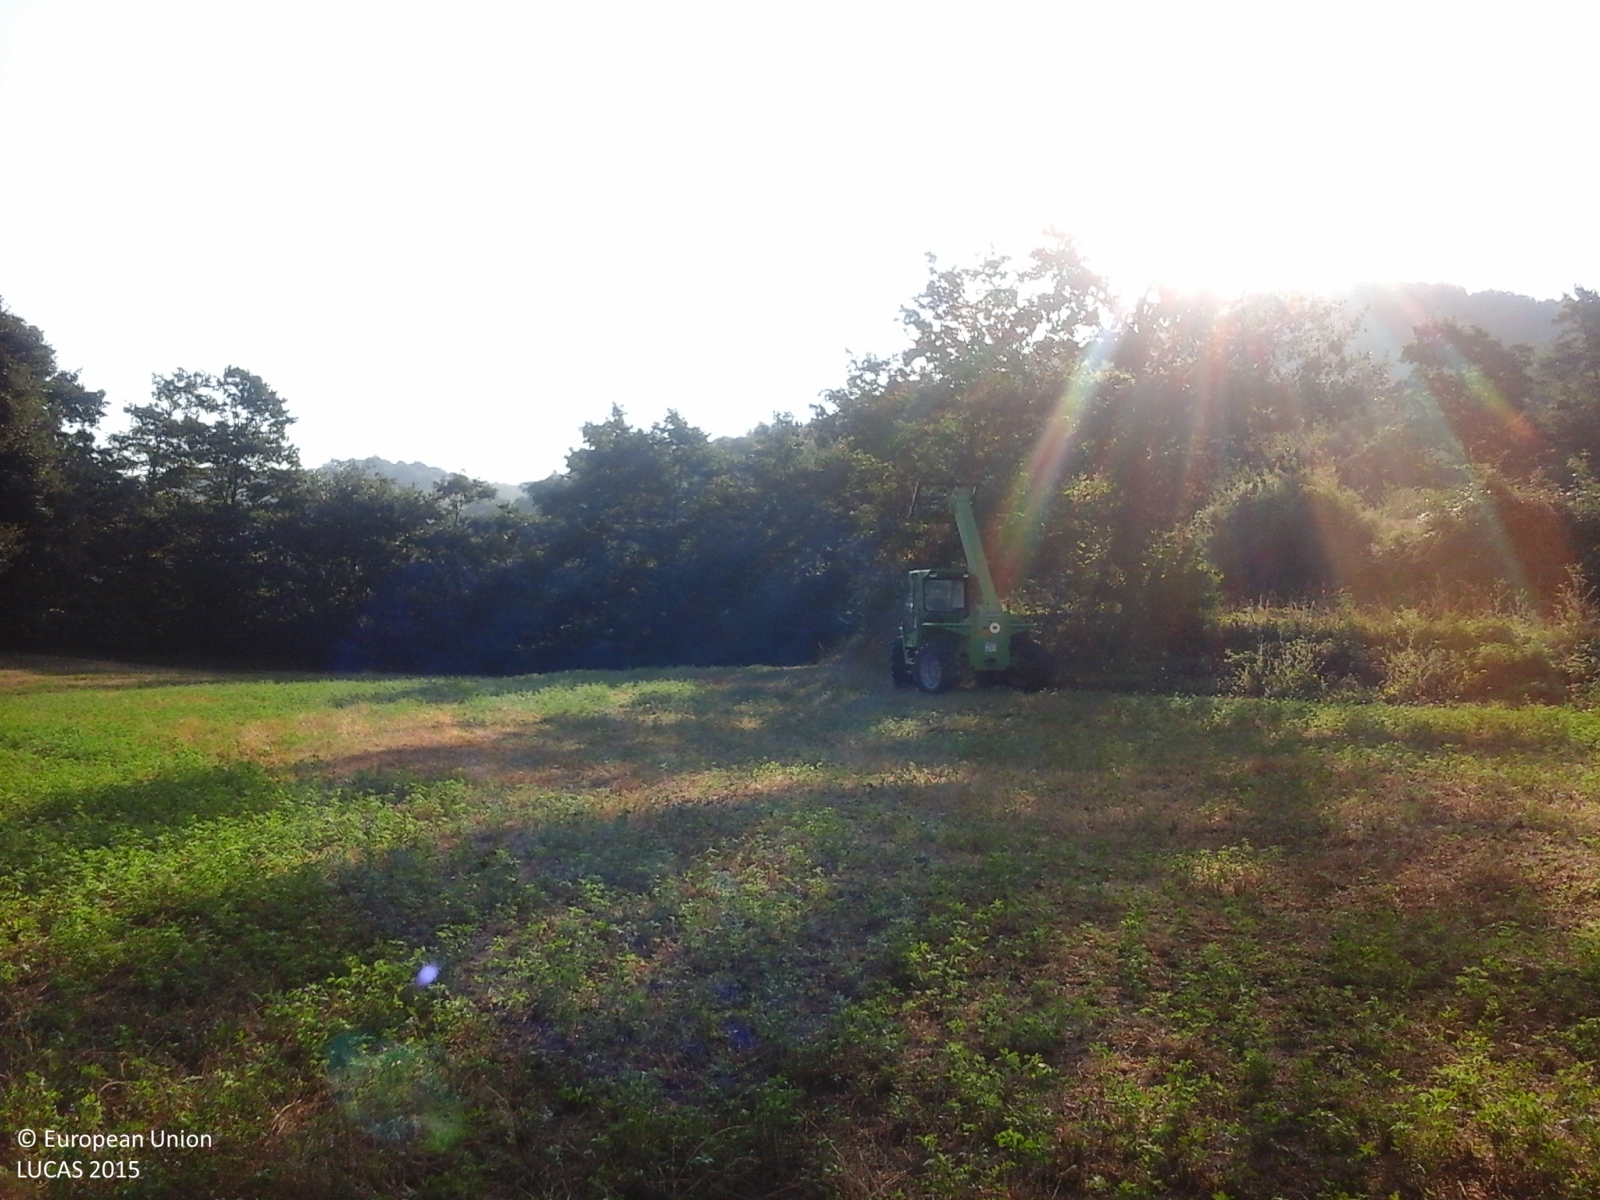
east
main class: Woodland
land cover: Broadleaved woodland
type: thermophilous deciduous forest
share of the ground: > 75 %
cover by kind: broadleaved forest trees 100 %
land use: Semi-natural and natural areas not in use
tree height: > 5 m
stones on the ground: < 10 %
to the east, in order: Broadleaved woodland; Lucerne; Grass margins; Paved roads, cycling and walking lanes; Abandoned hedges; Common wheat; Broadleaved woodland; Paved roads, cycling and walking lanes; Shrubland without tree cover; Broadleaved woodland; Lucerne
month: August
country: IT
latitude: 43.6007
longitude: 12.4095
